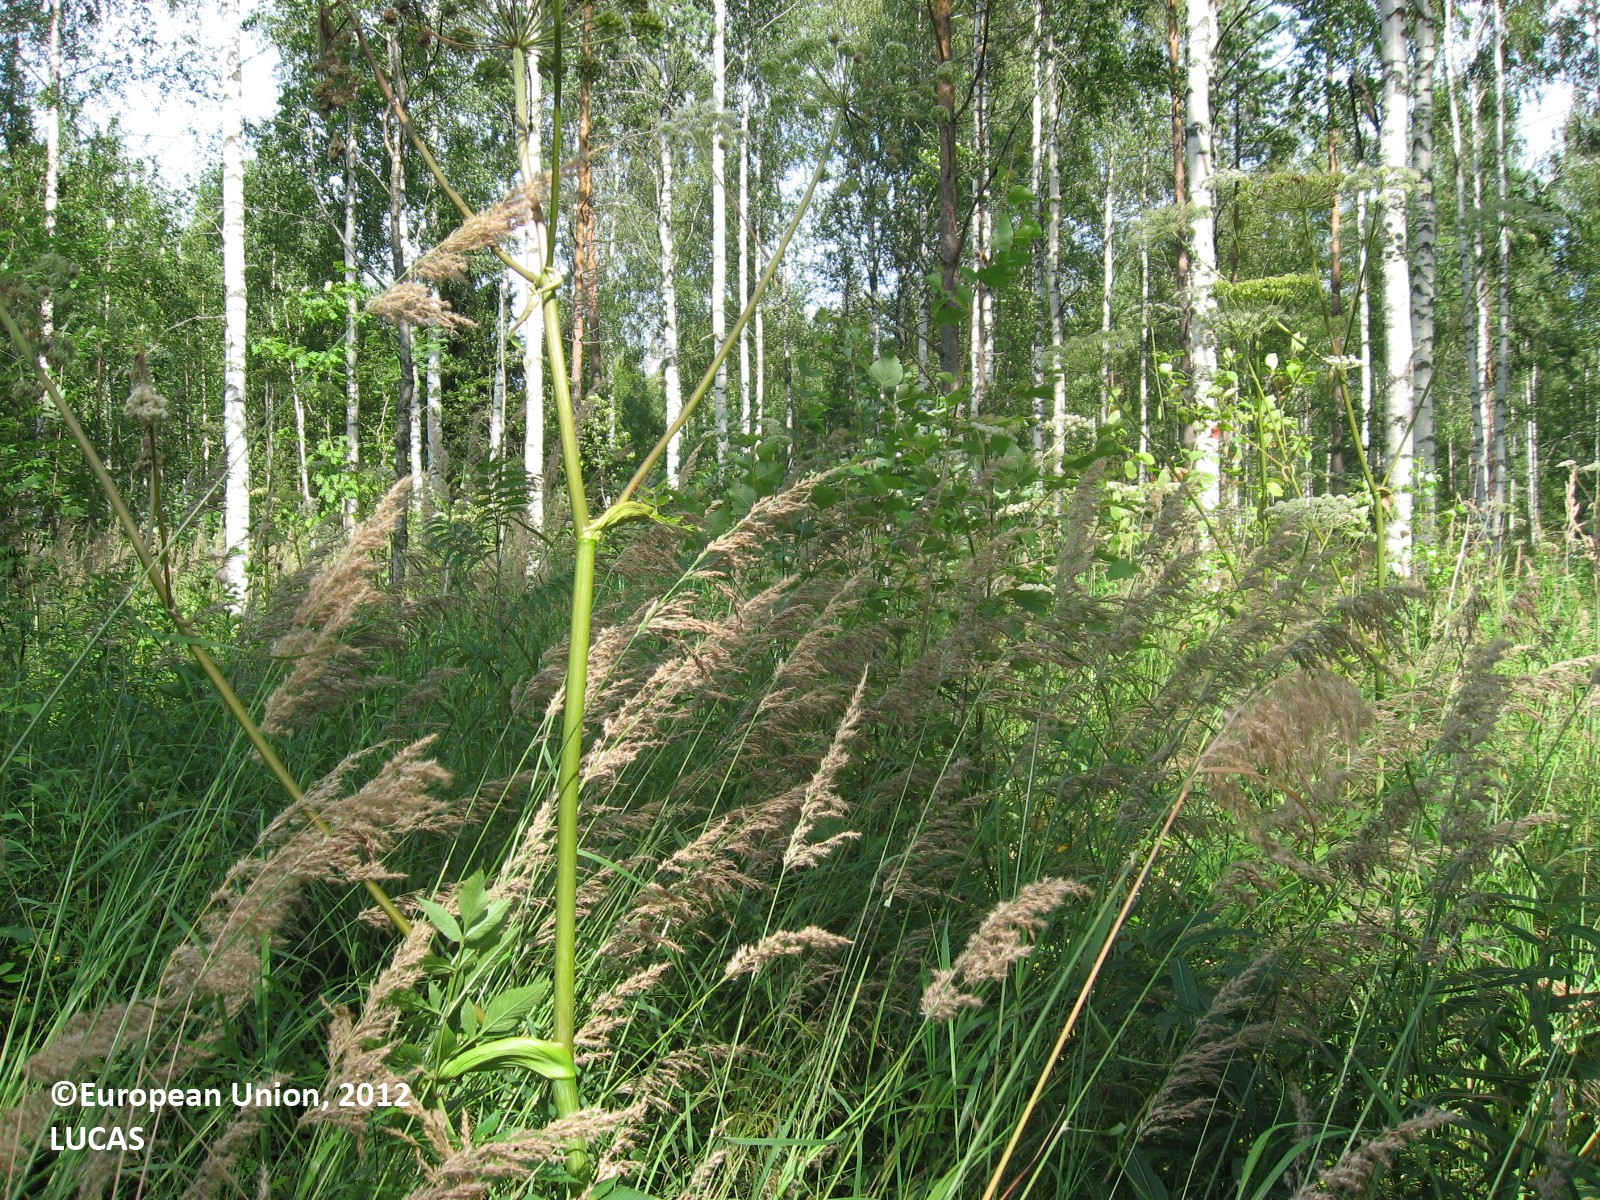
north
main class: Woodland
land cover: Broadleaved woodland
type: boreal forest
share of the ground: > 75 %
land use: Forestry
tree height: > 5 m
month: August
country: FI
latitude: 61.5416
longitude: 26.0302
